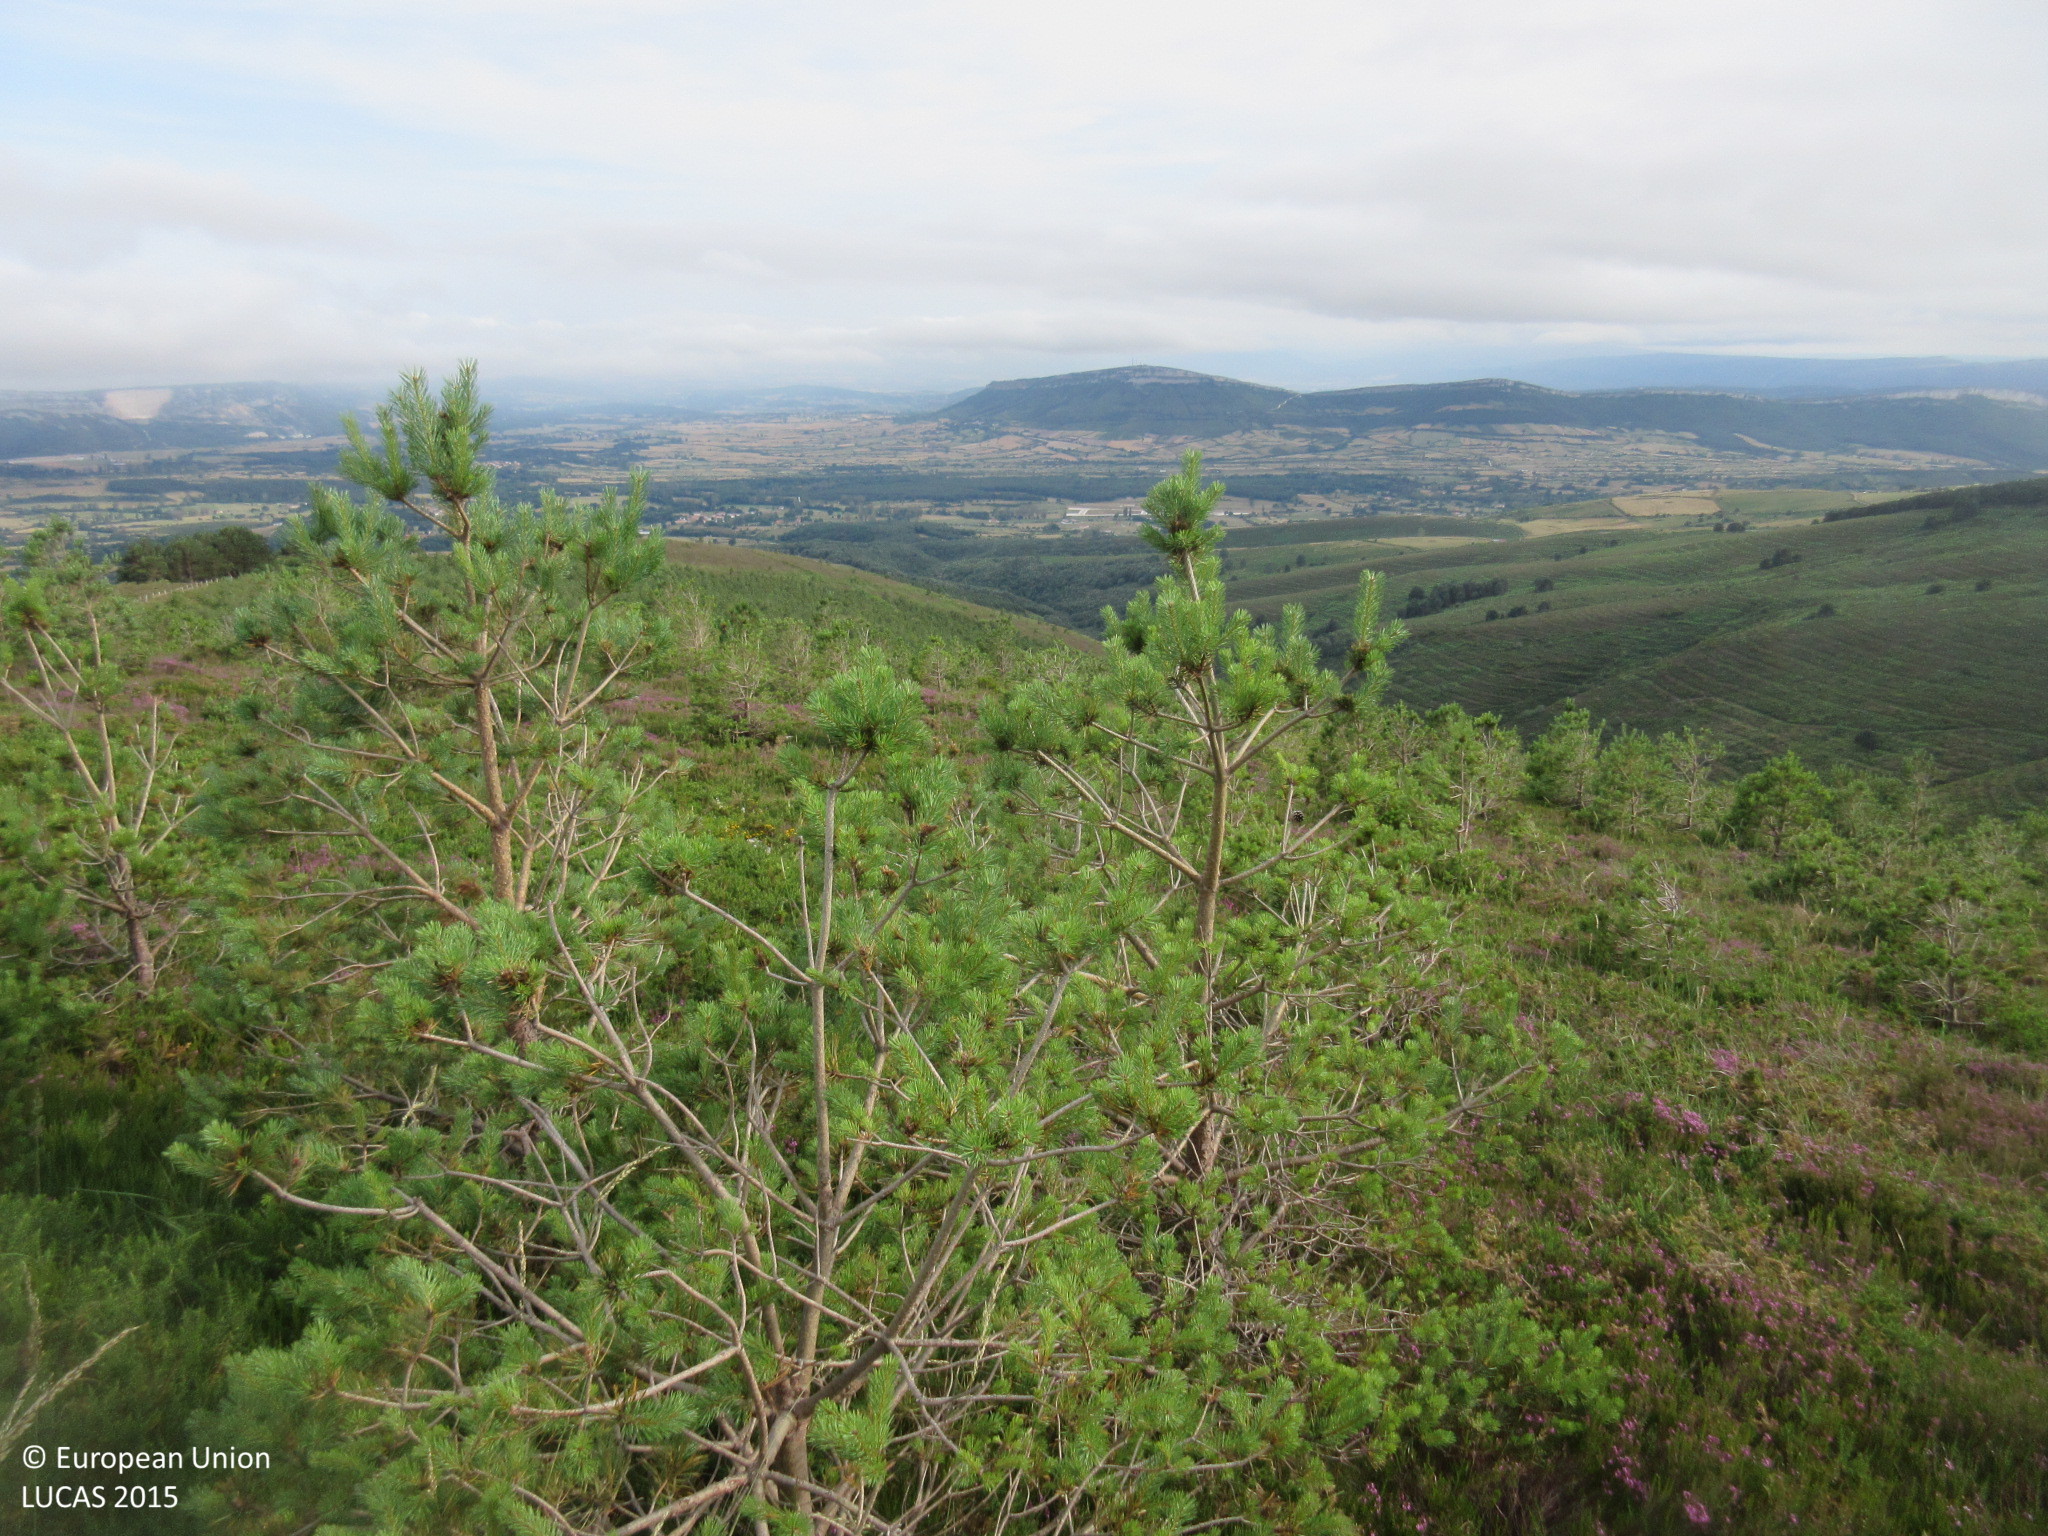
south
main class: Woodland
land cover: Pine dominated coniferous woodland
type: hemiboreal forest and nemoral coniferous forest and mixed broadleaved-coniferous forest
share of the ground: 25 - 50 %
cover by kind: shrubs 55 %, coniferous forest trees 45 %
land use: Forestry
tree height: < 5 m
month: July
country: ES
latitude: 43.1135
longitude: -3.5228
